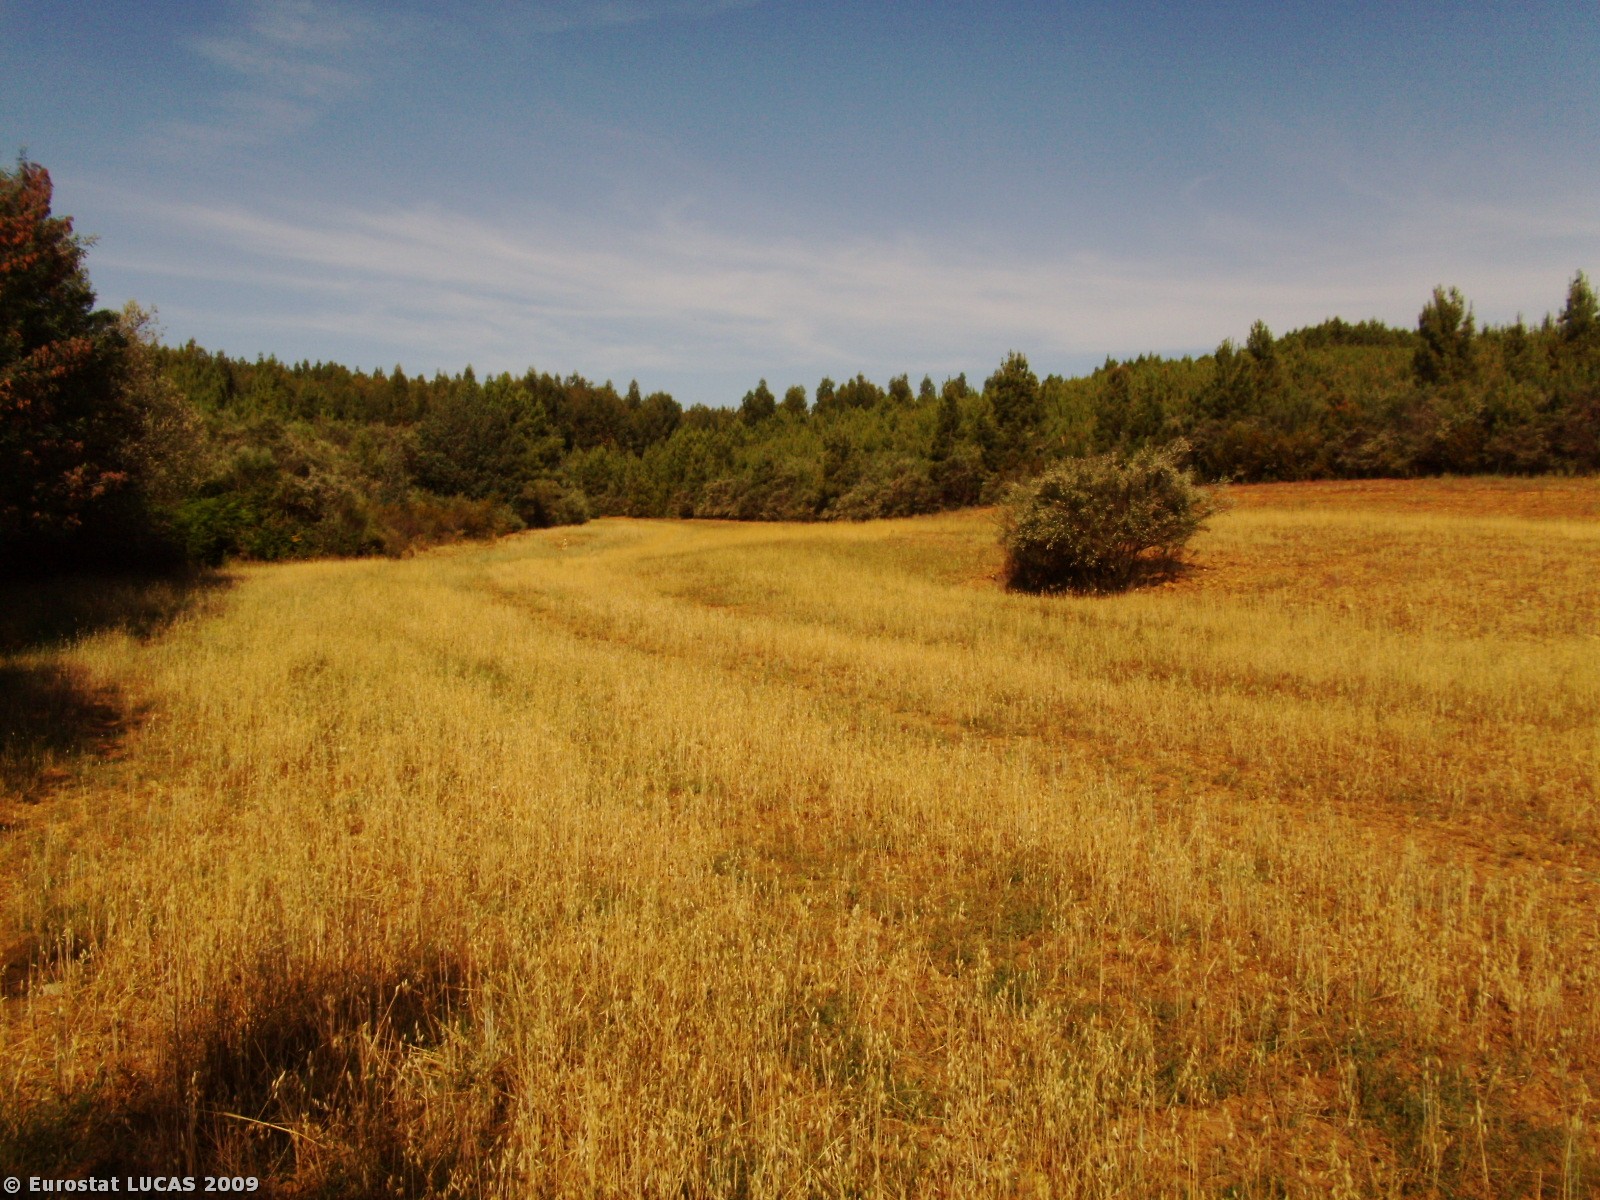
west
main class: Woodland
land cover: Coniferous woodland
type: coniferous forest of the mediterranean region
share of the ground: > 75 %
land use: Forestry
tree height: > 5 m
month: June
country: PT
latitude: 40.1482
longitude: -7.3453
